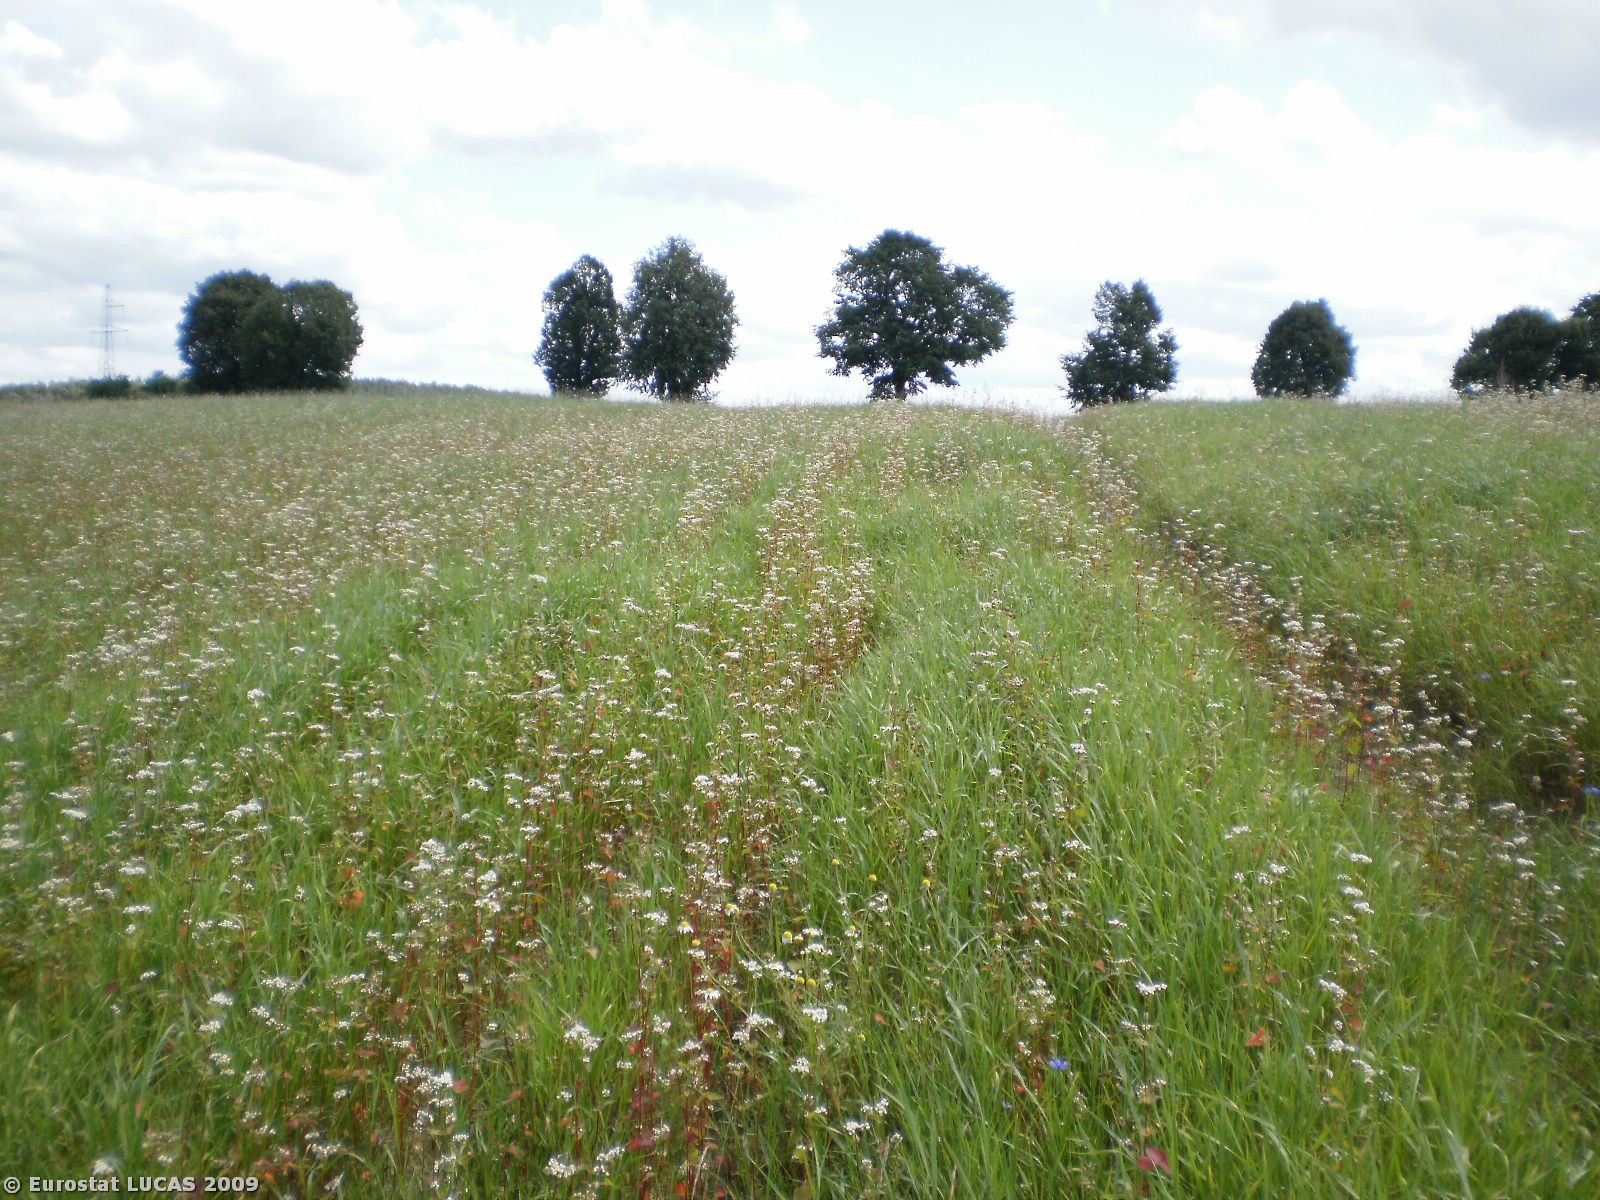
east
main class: Cropland
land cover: Other cereals
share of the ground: > 75 %
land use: Agriculture (excluding fallow land and kitchen gardens)
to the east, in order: Other cereals; Ditches and canals; Grass margins; Paved roads, cycling and walking lanes; Grass margins; Ditches and canals; Lines of trees; Grassland without tree/shrub cover; Spontaneously vegetated surfaces
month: July
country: PL
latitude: 53.4239
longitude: 20.4047
